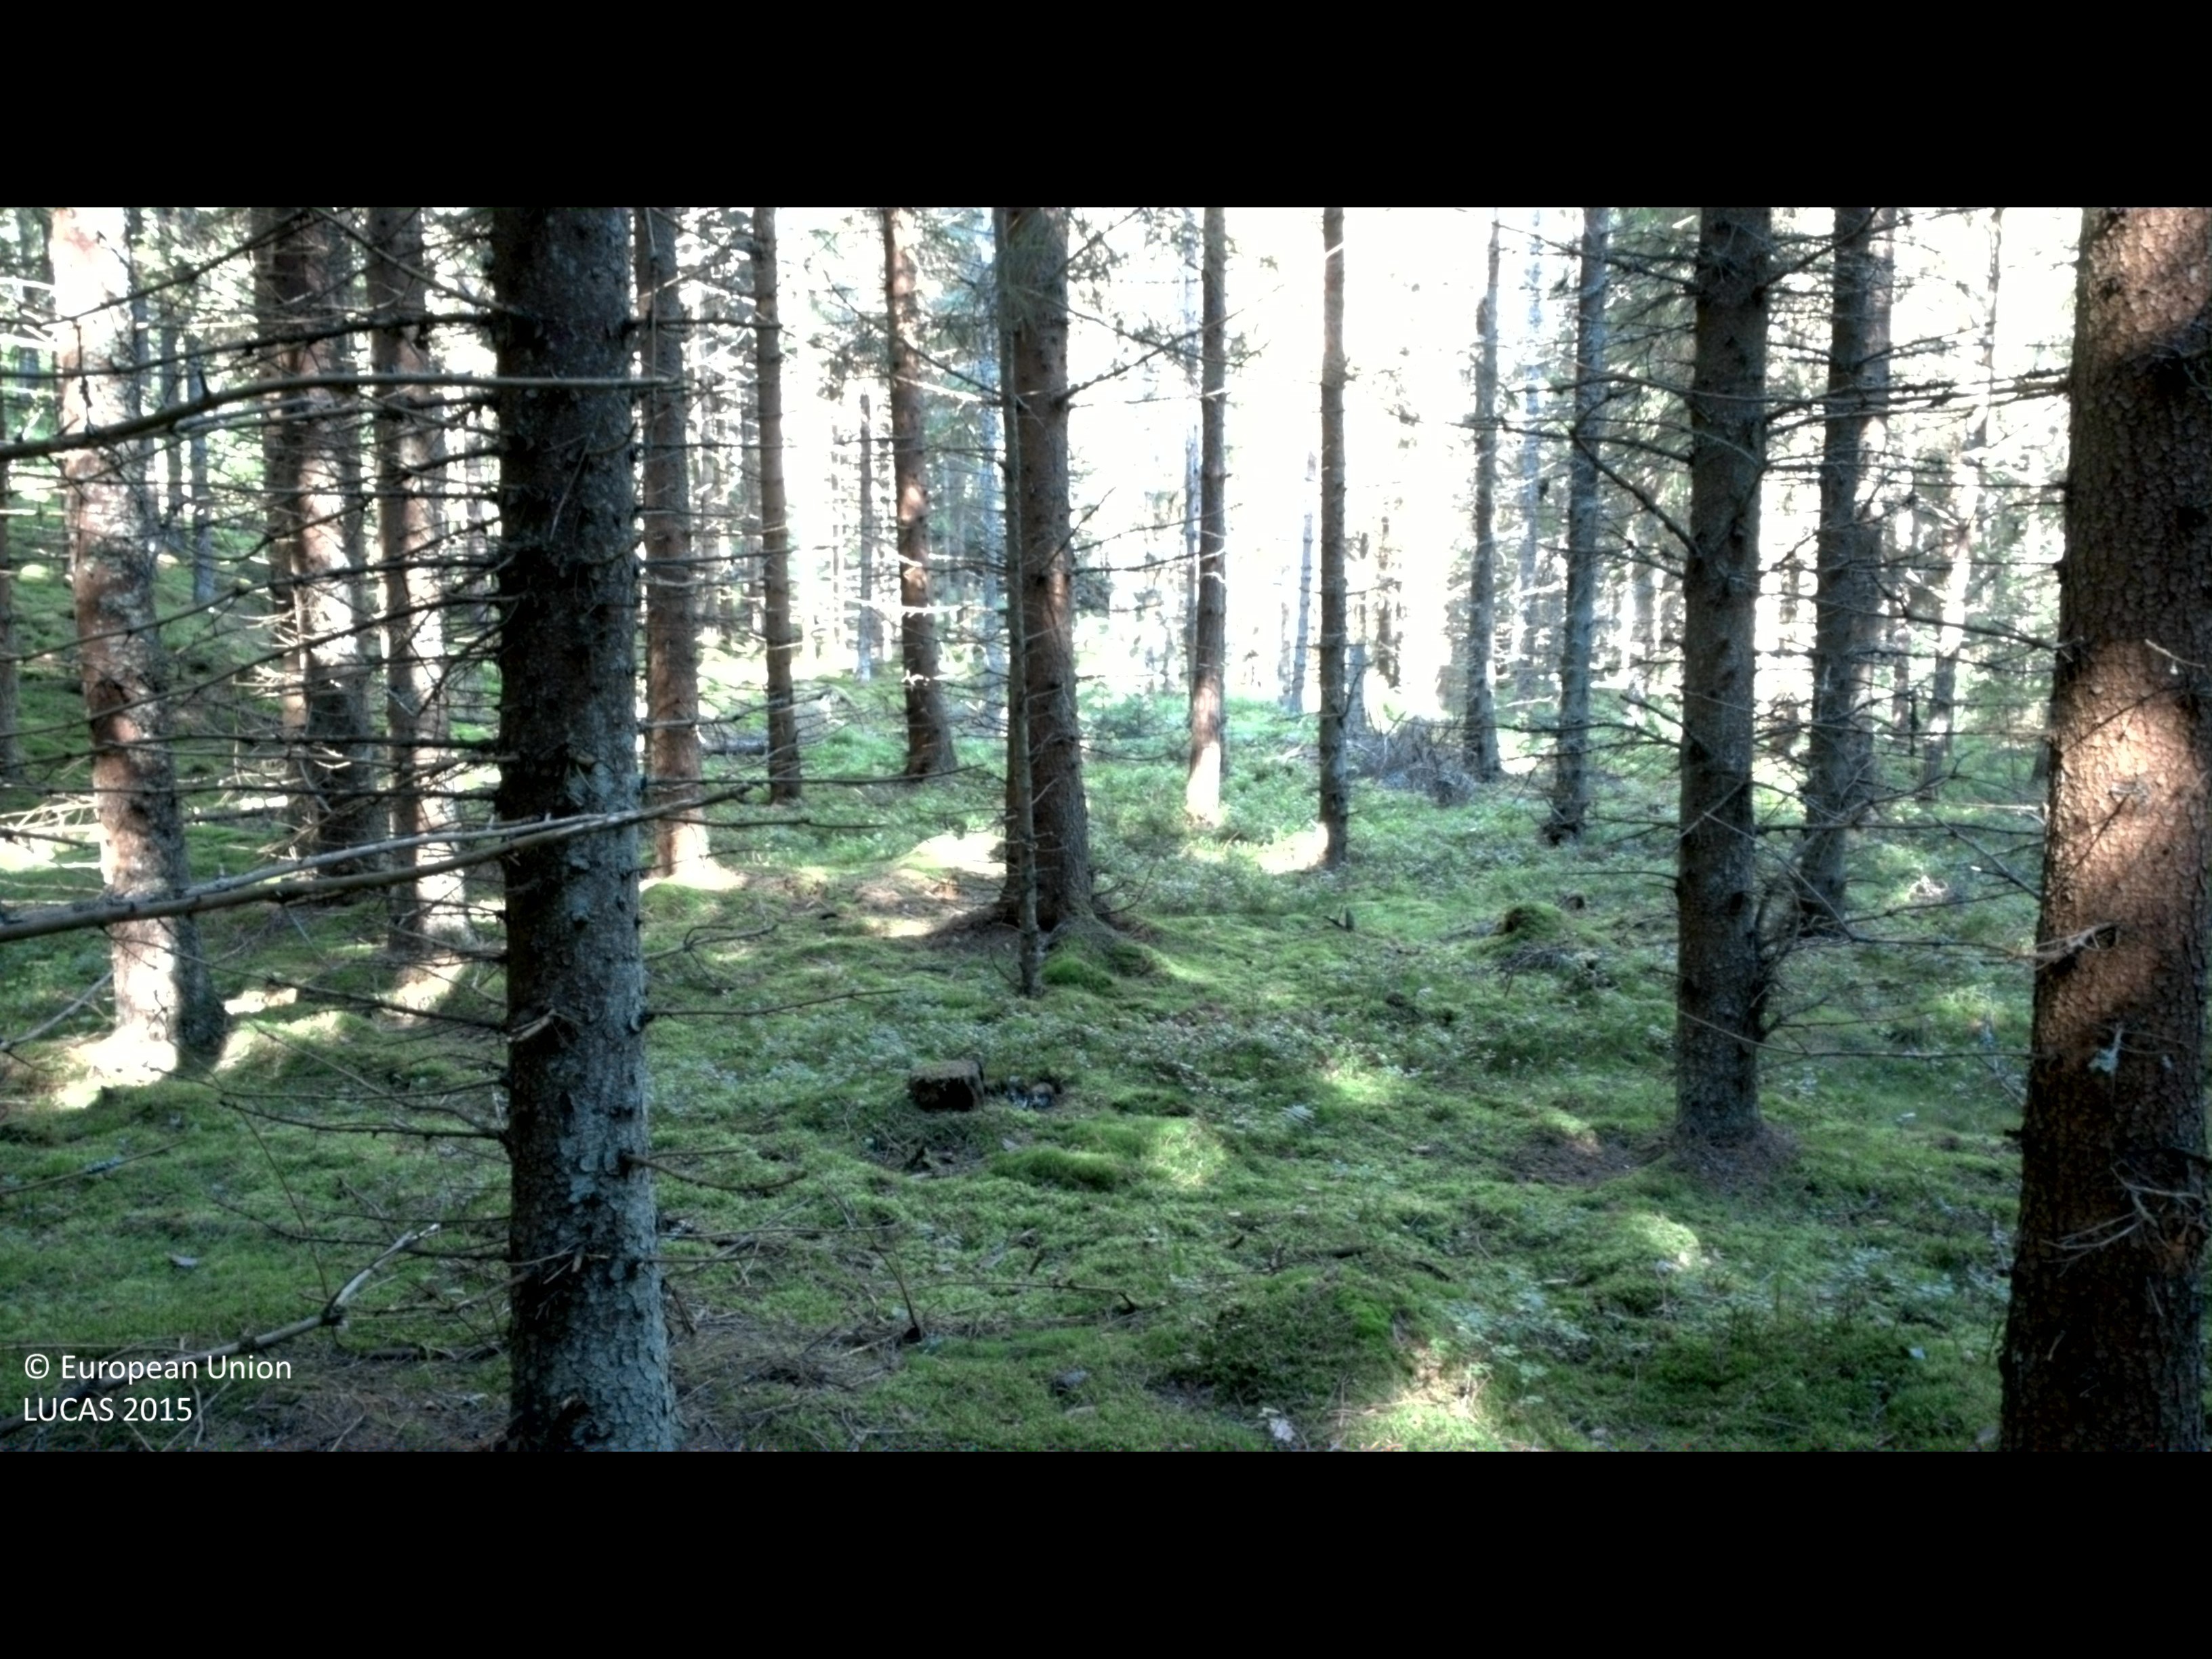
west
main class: Woodland
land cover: Spruce dominated coniferous woodland
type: boreal forest
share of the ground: > 75 %
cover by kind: coniferous forest trees 85 %, lichens and mosses 10 %, shrubs 5 %
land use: Forestry
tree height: > 5 m
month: July
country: SE
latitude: 58.2009
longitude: 16.2408
